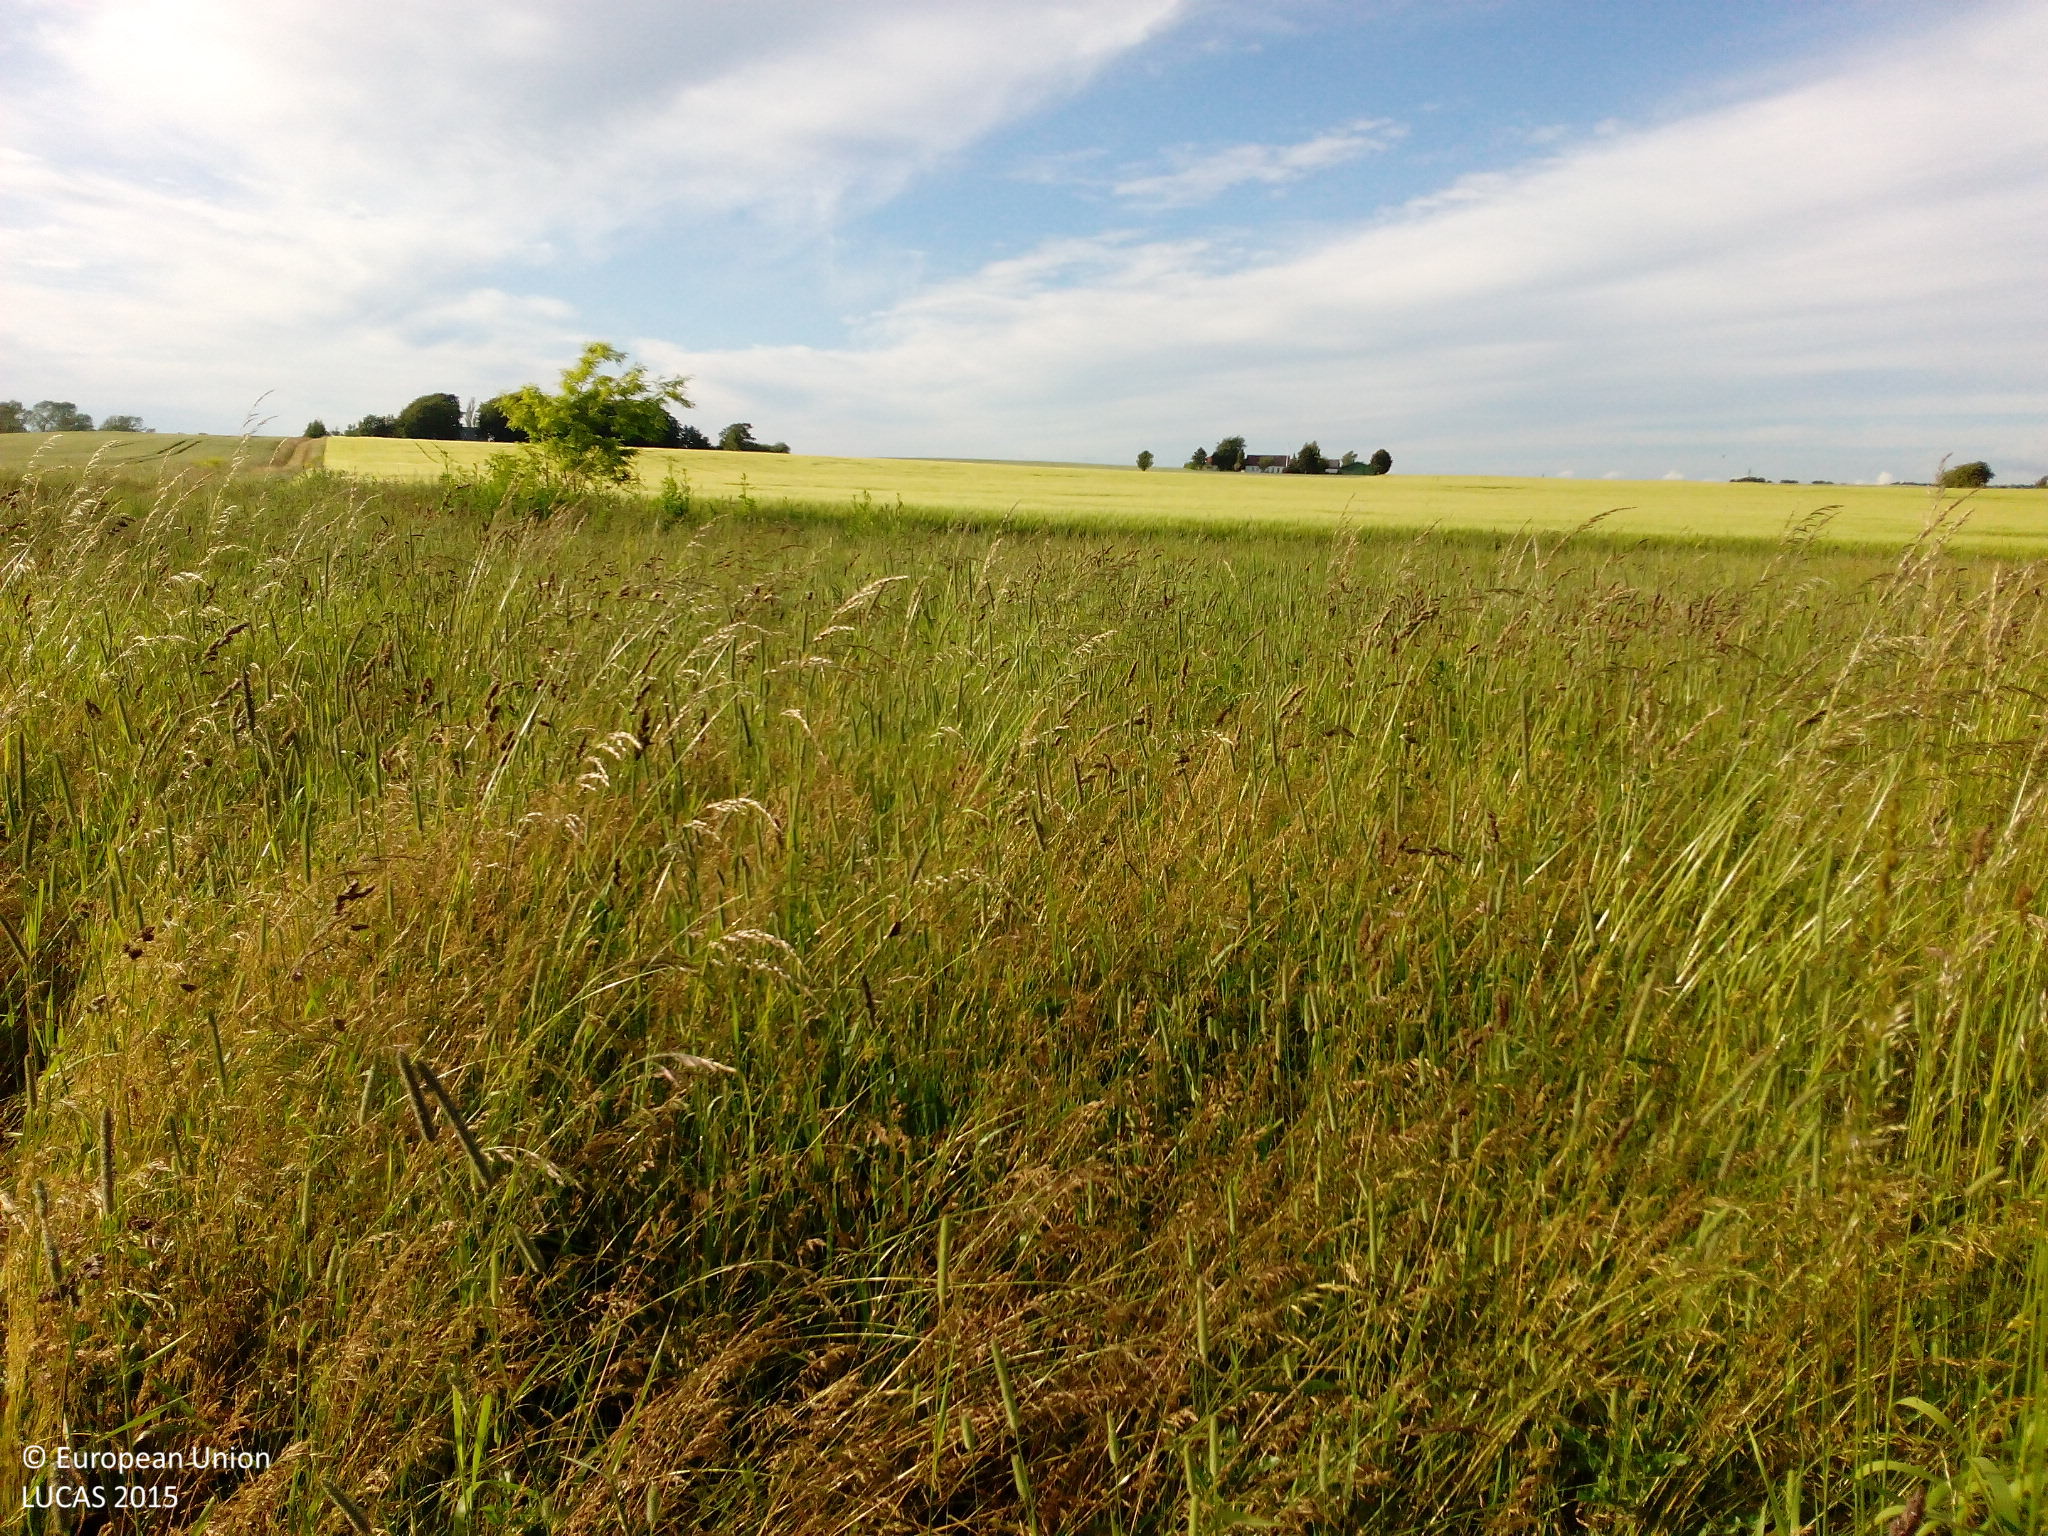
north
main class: Grassland
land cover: Grassland without tree/shrub cover
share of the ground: > 75 %
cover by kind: herbaceous plants 100 %
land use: Agriculture (excluding fallow land and kitchen gardens)
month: June
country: DK
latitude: 55.0591
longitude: 11.8931
